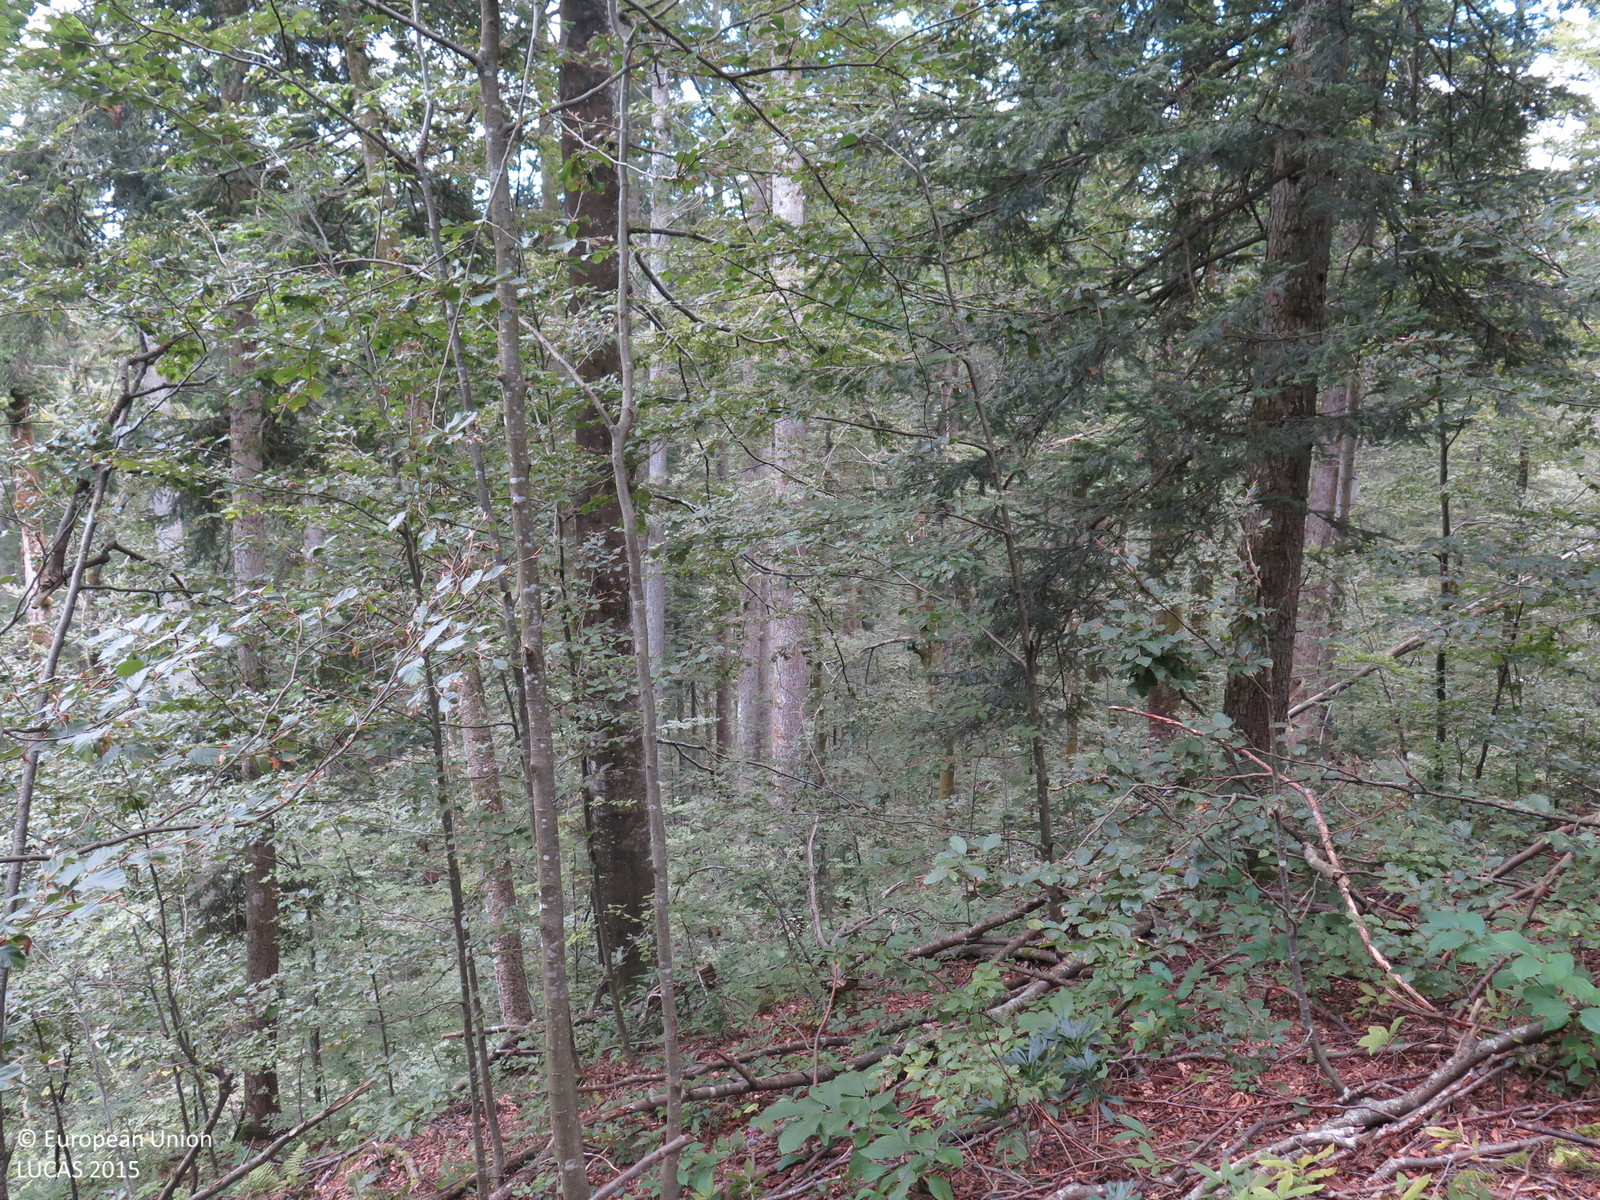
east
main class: Woodland
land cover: Other mixed woodland
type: mountainous beech forest
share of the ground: > 75 %
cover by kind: broadleaved forest trees 75 %, coniferous forest trees 25 %
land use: Forestry
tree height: > 5 m
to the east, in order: Other mixed woodland
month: September
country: HR
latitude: 45.3791
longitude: 14.7585
